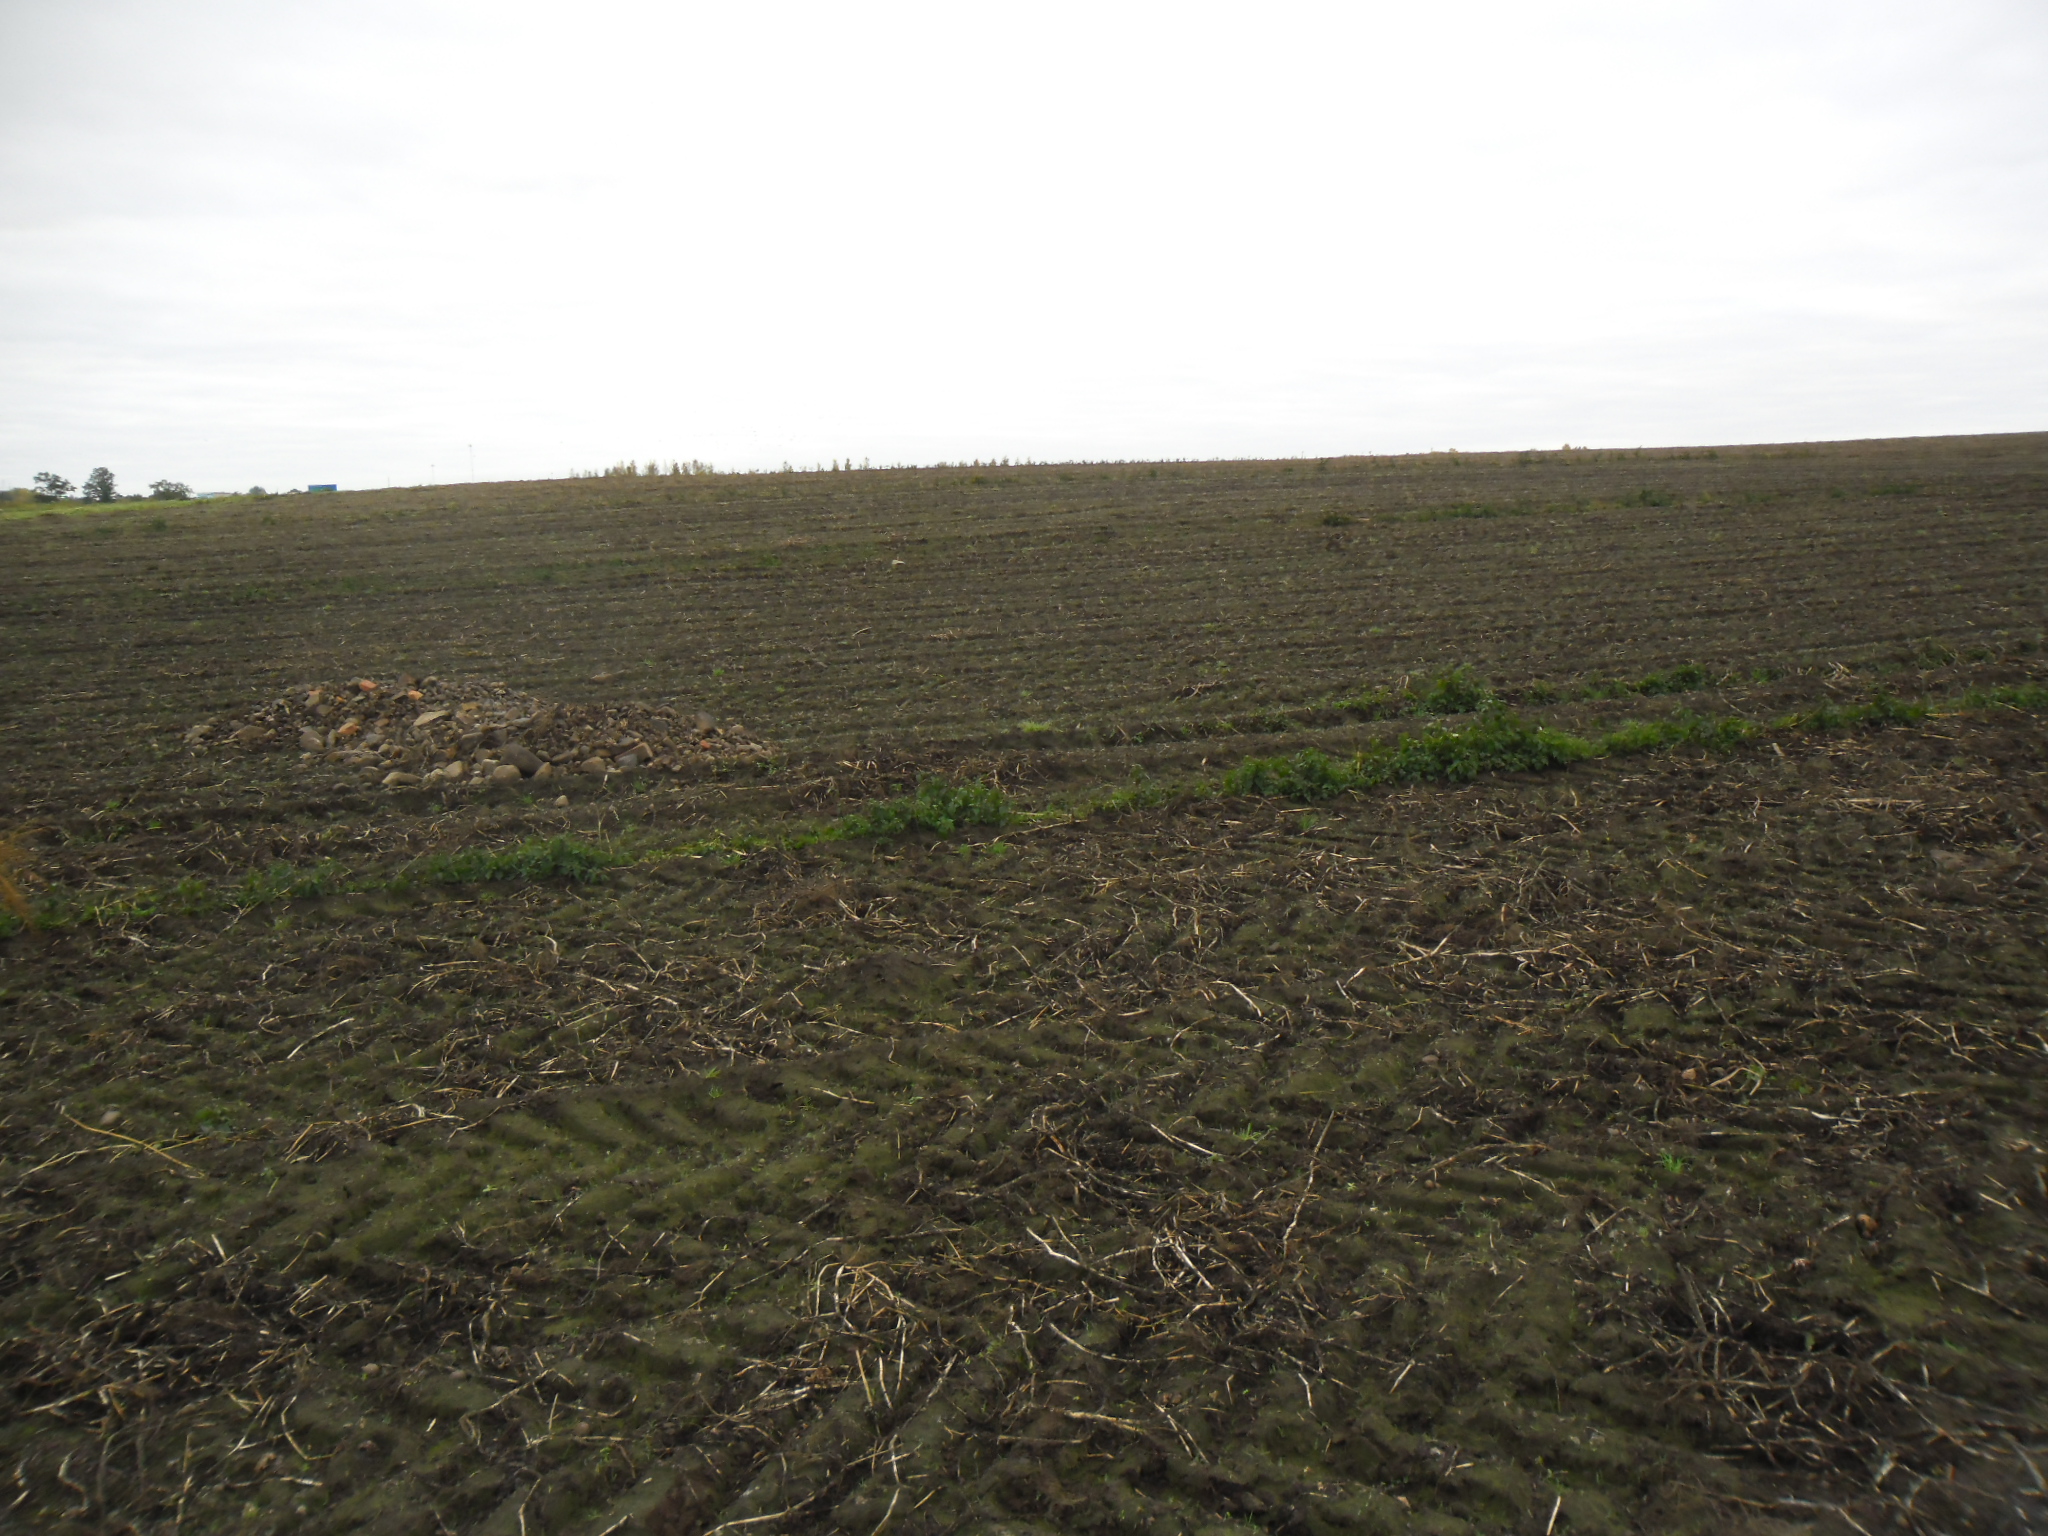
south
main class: Cropland
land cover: Potatoes
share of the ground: < 10 %
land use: Agriculture (excluding fallow land and kitchen gardens)
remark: Harvested field
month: October
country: SE
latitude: 56.1870
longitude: 13.7517
